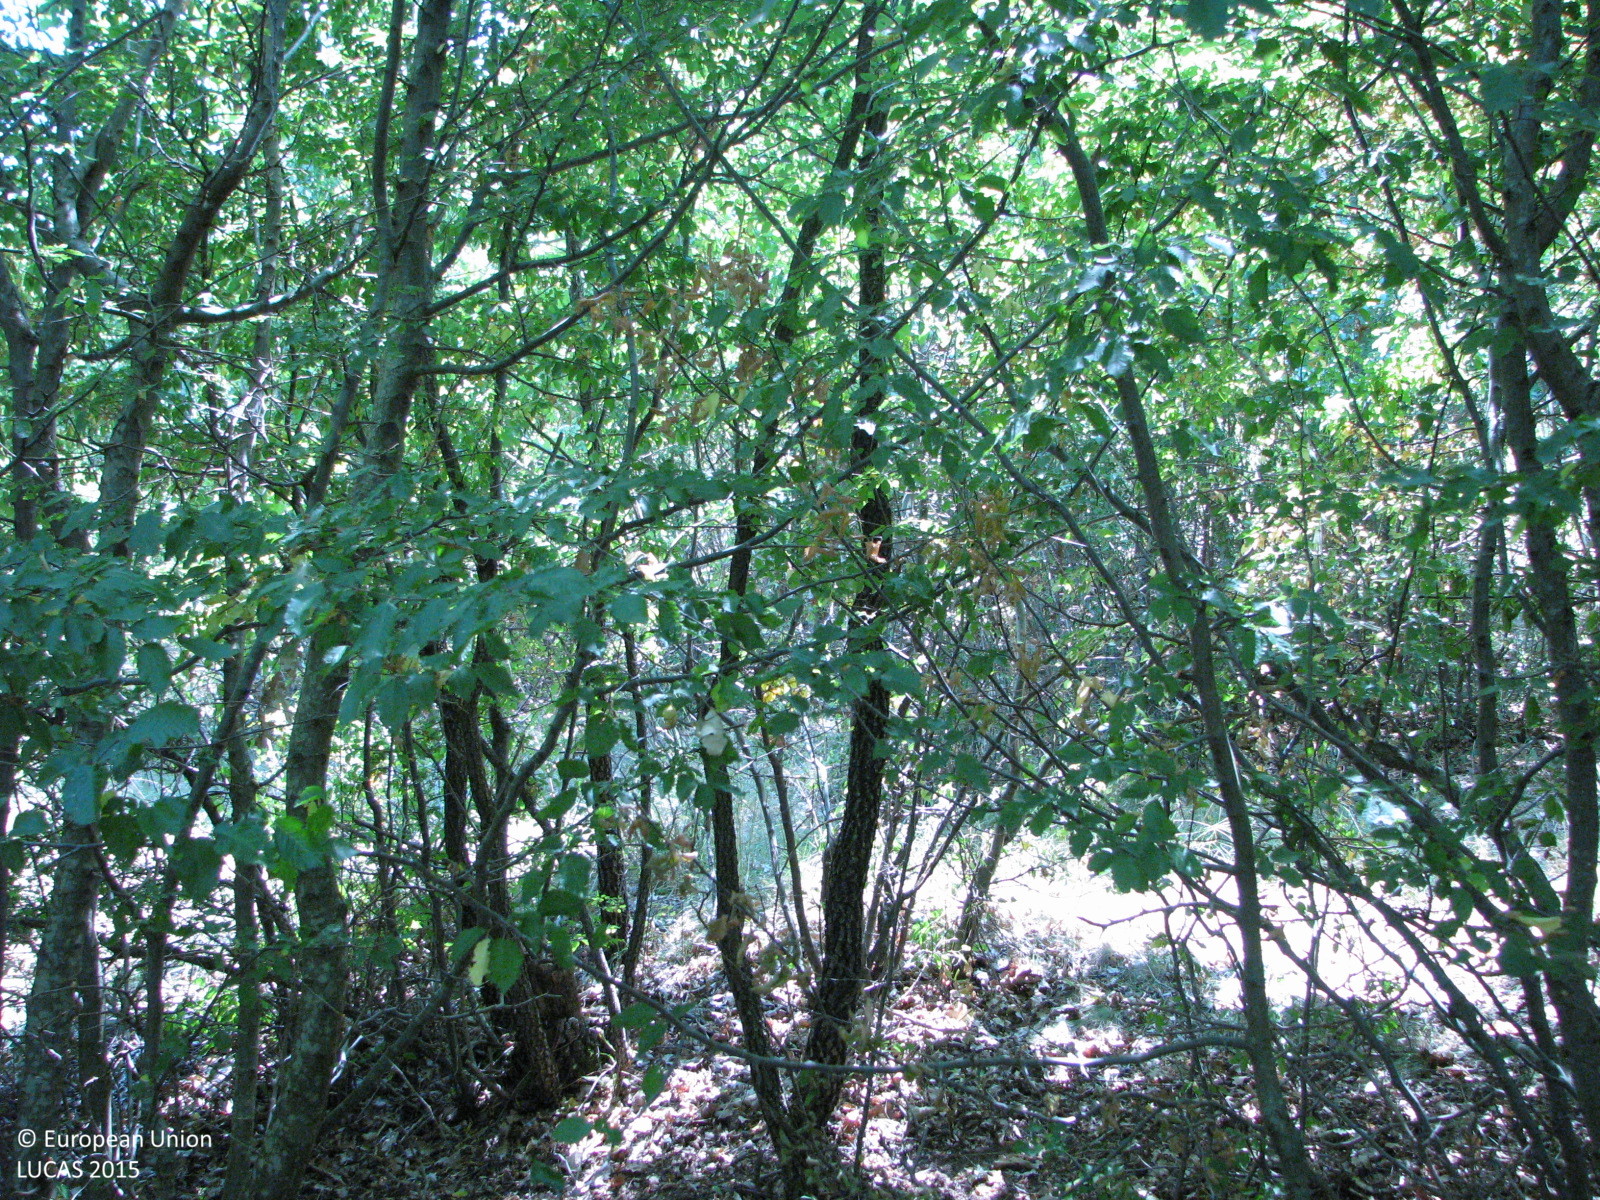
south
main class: Woodland
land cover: Broadleaved woodland
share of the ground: 50 - 75 %
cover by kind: broadleaved forest trees 50 %, herbaceous plants 40 %, shrubs 10 %
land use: Forestry
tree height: < 5 m
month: July
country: BG
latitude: 42.6466
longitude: 26.0746
